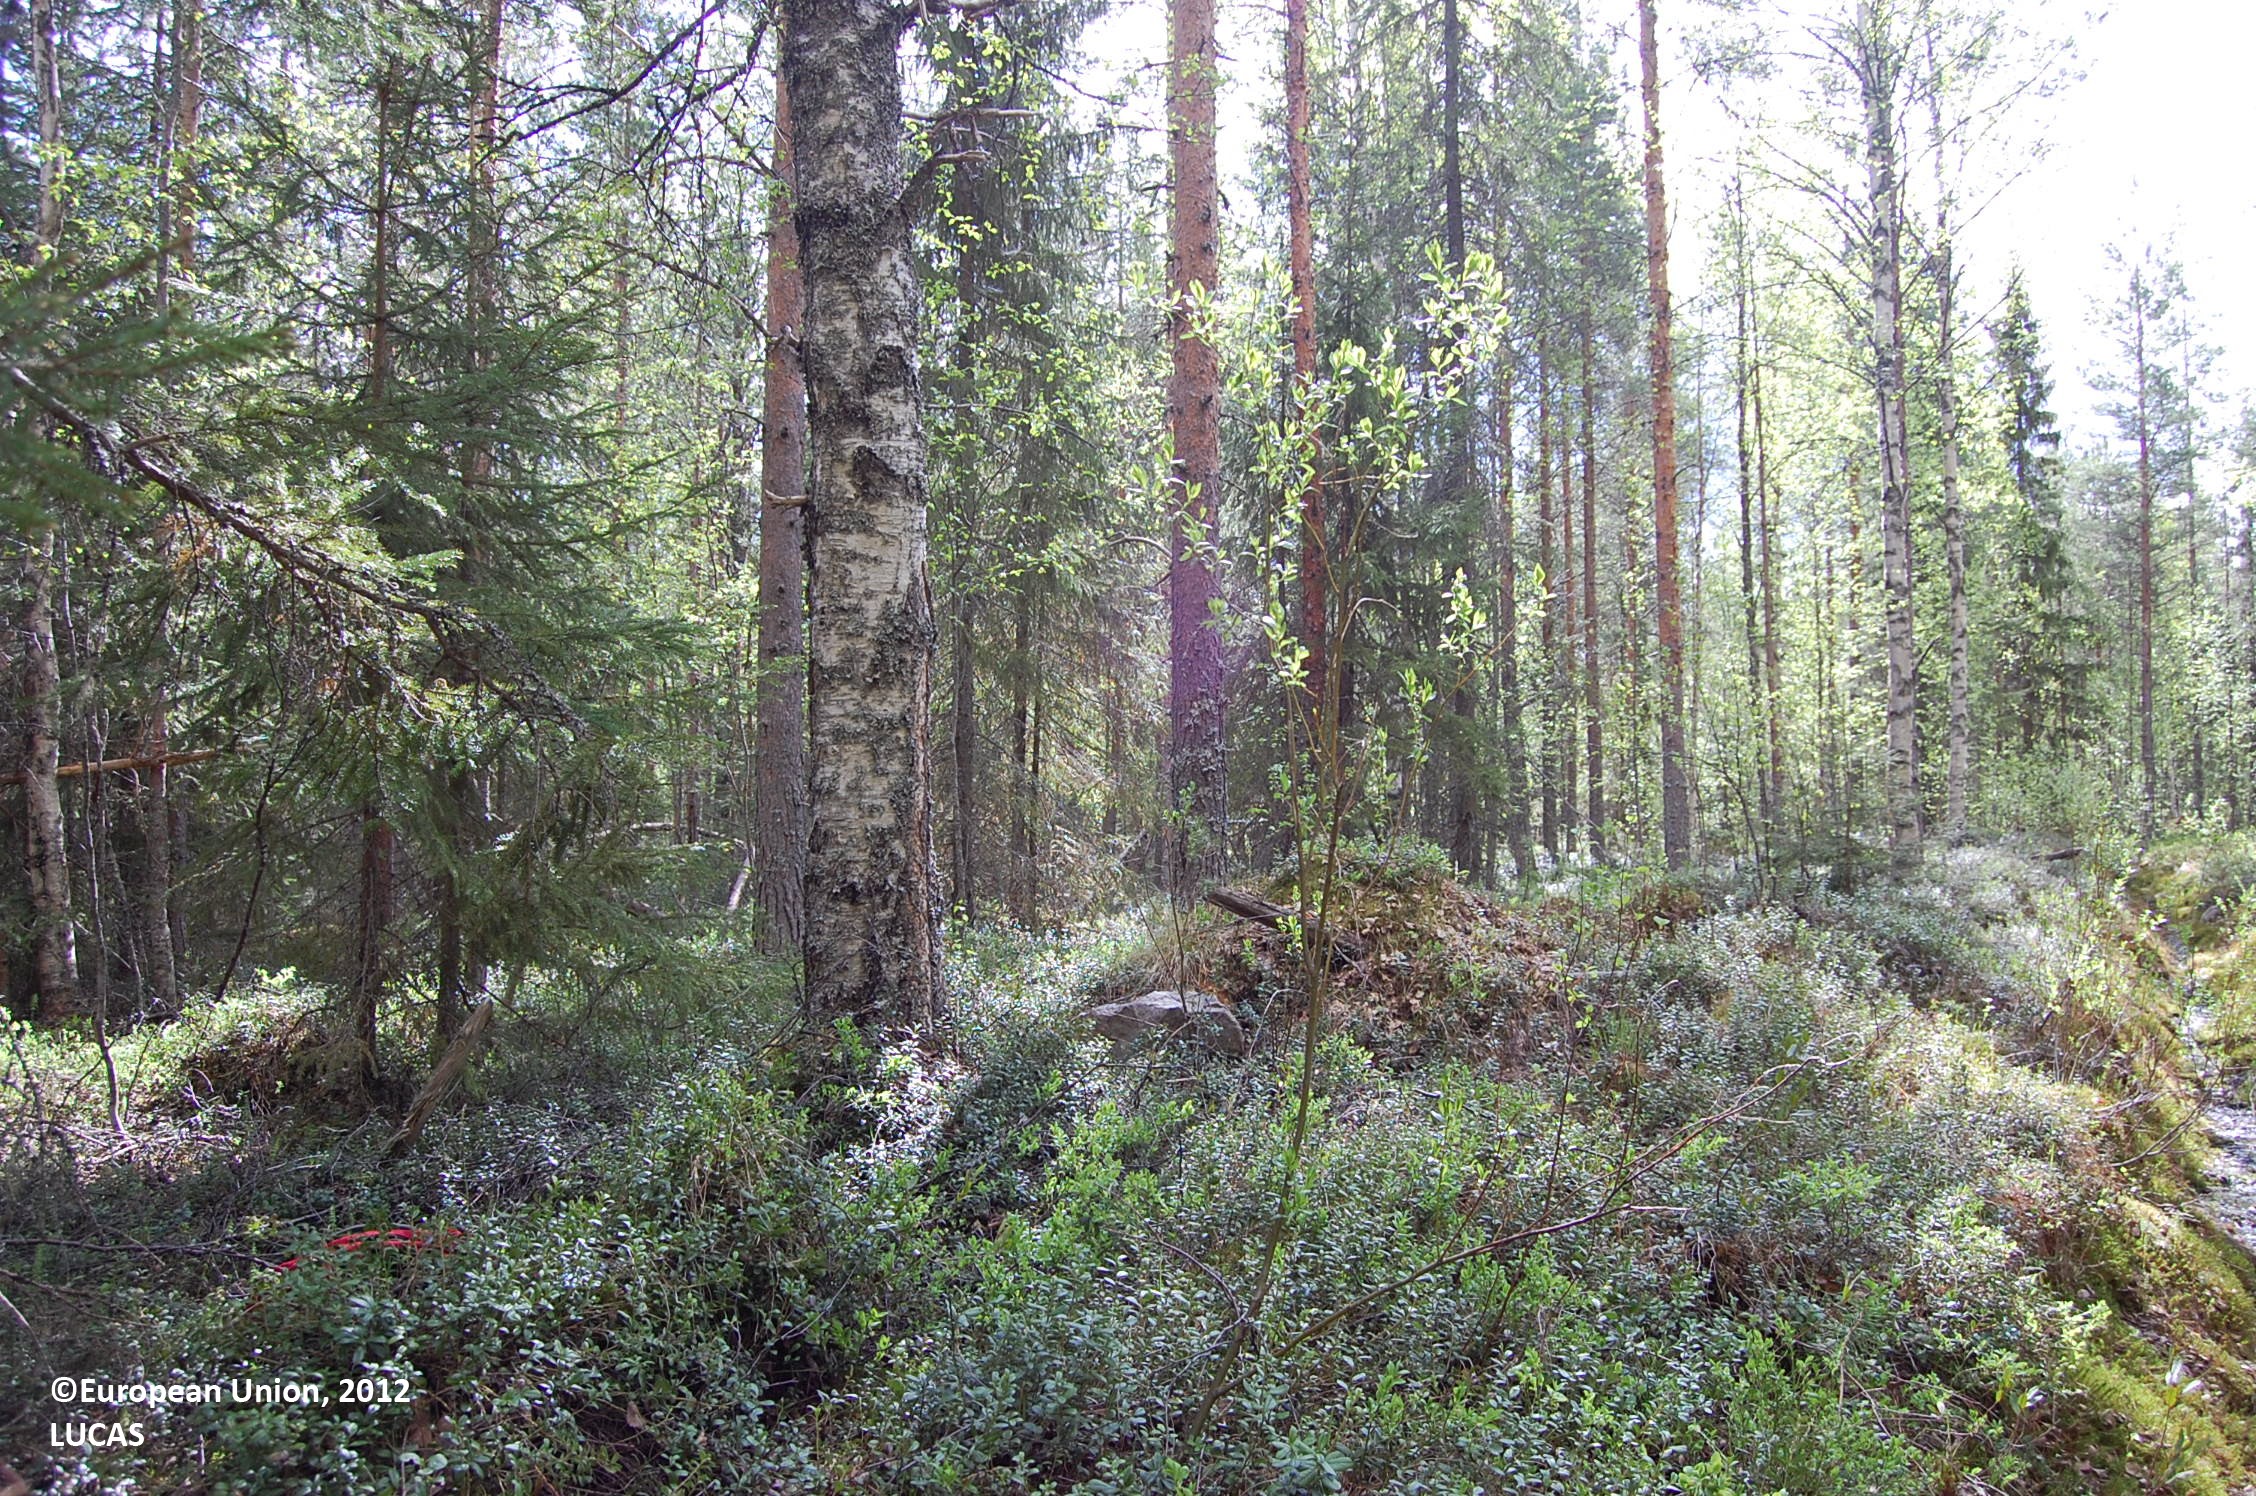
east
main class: Woodland
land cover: Other mixed woodland
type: boreal forest
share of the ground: > 75 %
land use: Forestry
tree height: > 5 m
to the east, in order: Other mixed woodland; Spruce dominated mixed woodland; Ditches and canals; Spruce dominated mixed woodland; Ditches and canals; Pine dominated mixed woodland; Ditches and canals; Broadleaved woodland; Ditches and canals; Pine dominated coniferous woodland; Pine dominated mixed woodland
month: May
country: FI
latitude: 64.2933
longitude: 26.2480
